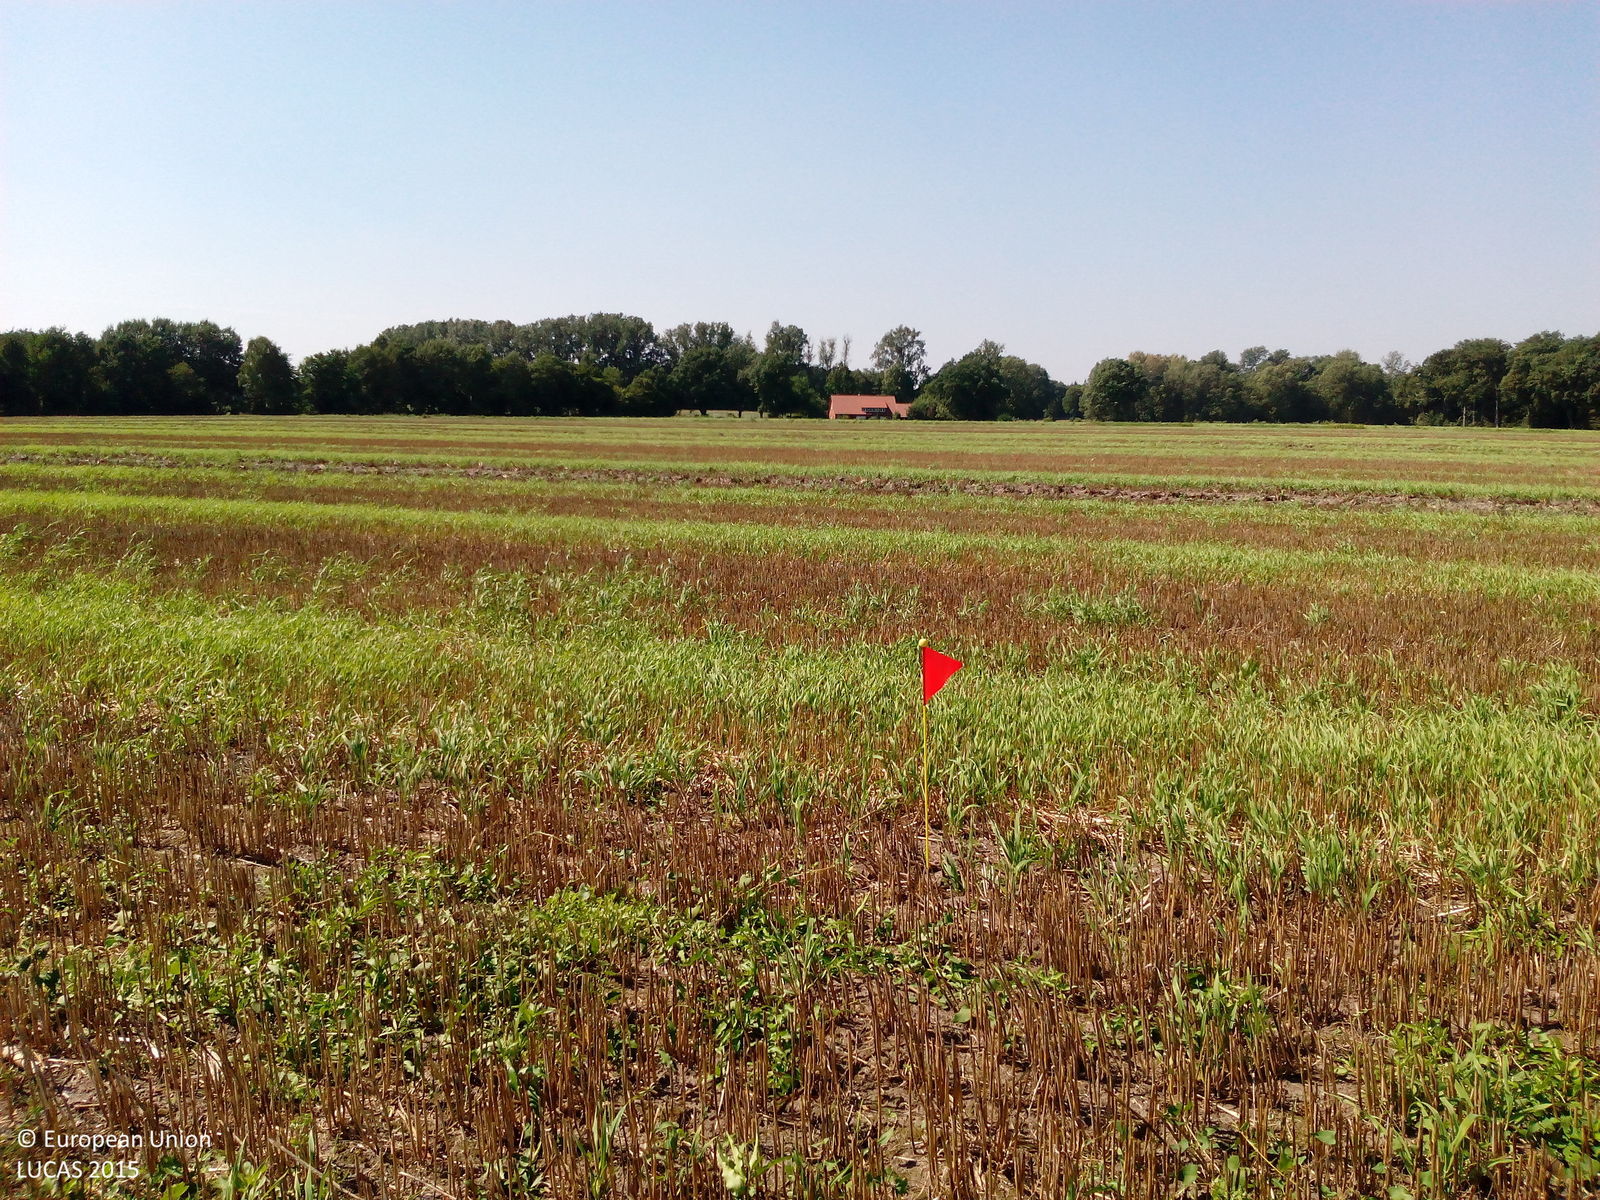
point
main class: Cropland
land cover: Barley
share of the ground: > 75 %
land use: Agriculture (excluding fallow land and kitchen gardens)
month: August
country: DE
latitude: 52.7562
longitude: 8.0002
